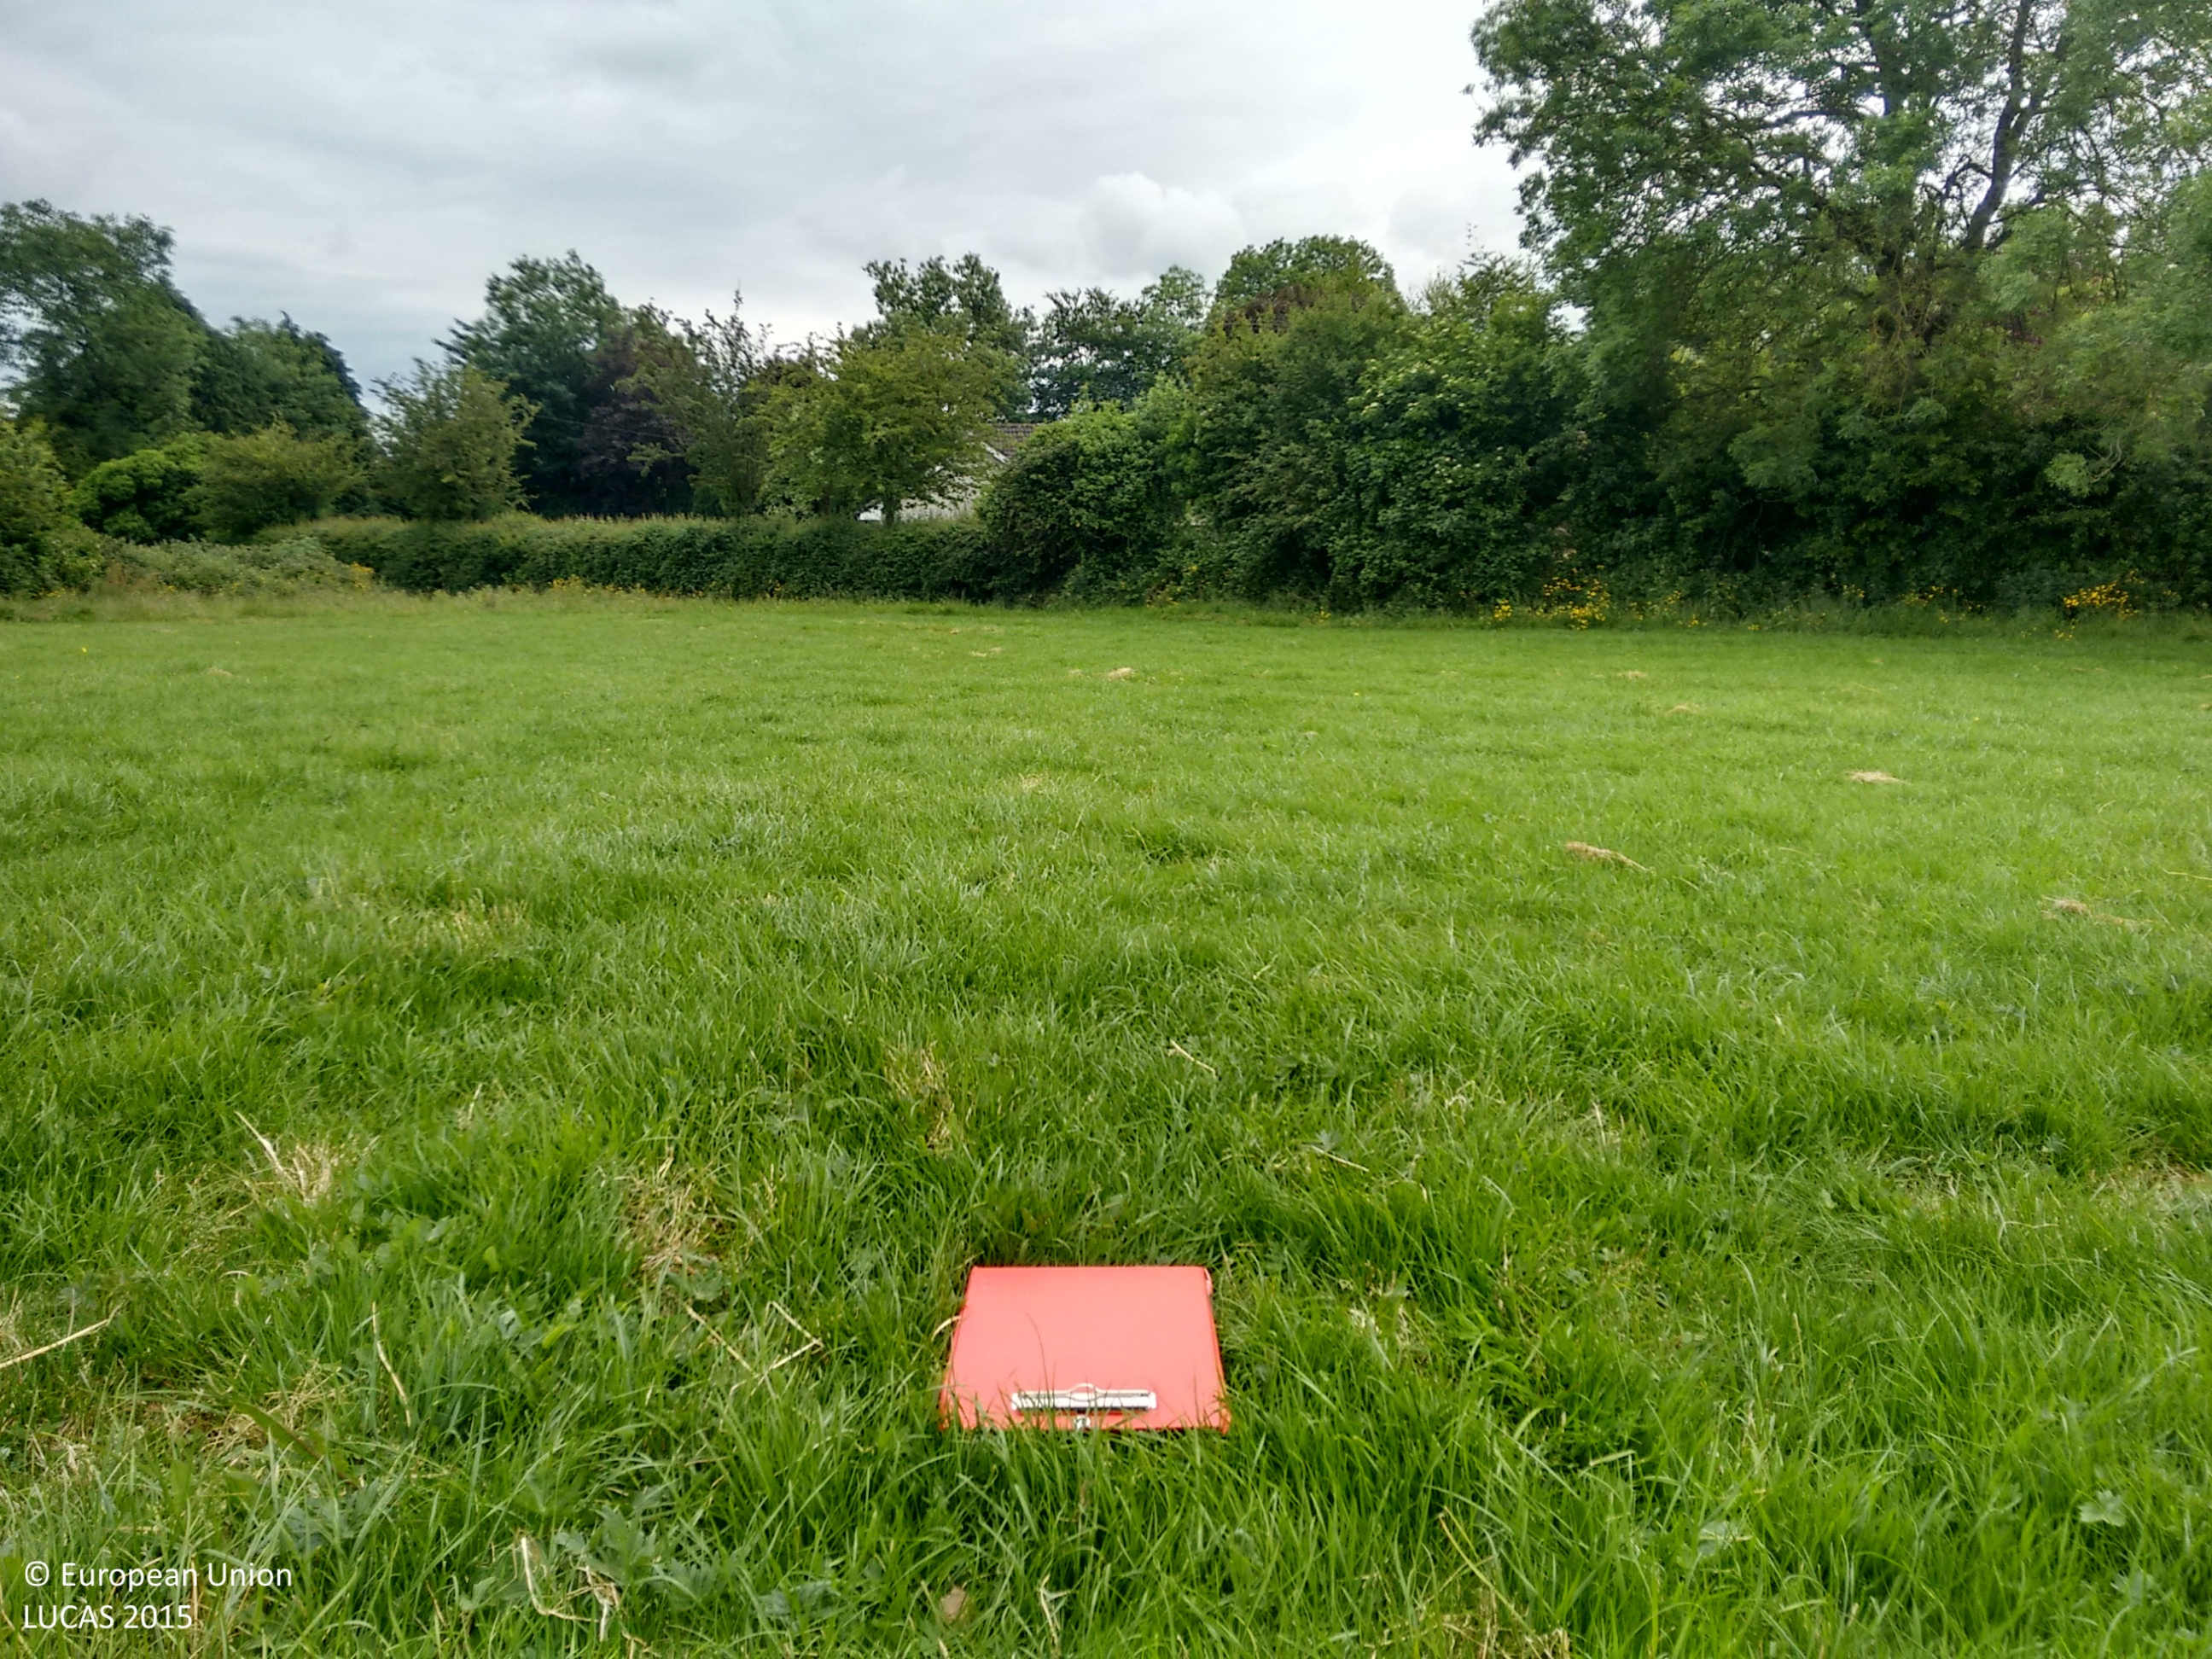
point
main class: Grassland
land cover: Grassland without tree/shrub cover
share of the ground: > 75 %
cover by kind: herbaceous plants 100 %
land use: Agriculture (excluding fallow land and kitchen gardens)
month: June
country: IE
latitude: 53.6424
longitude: -6.7266
